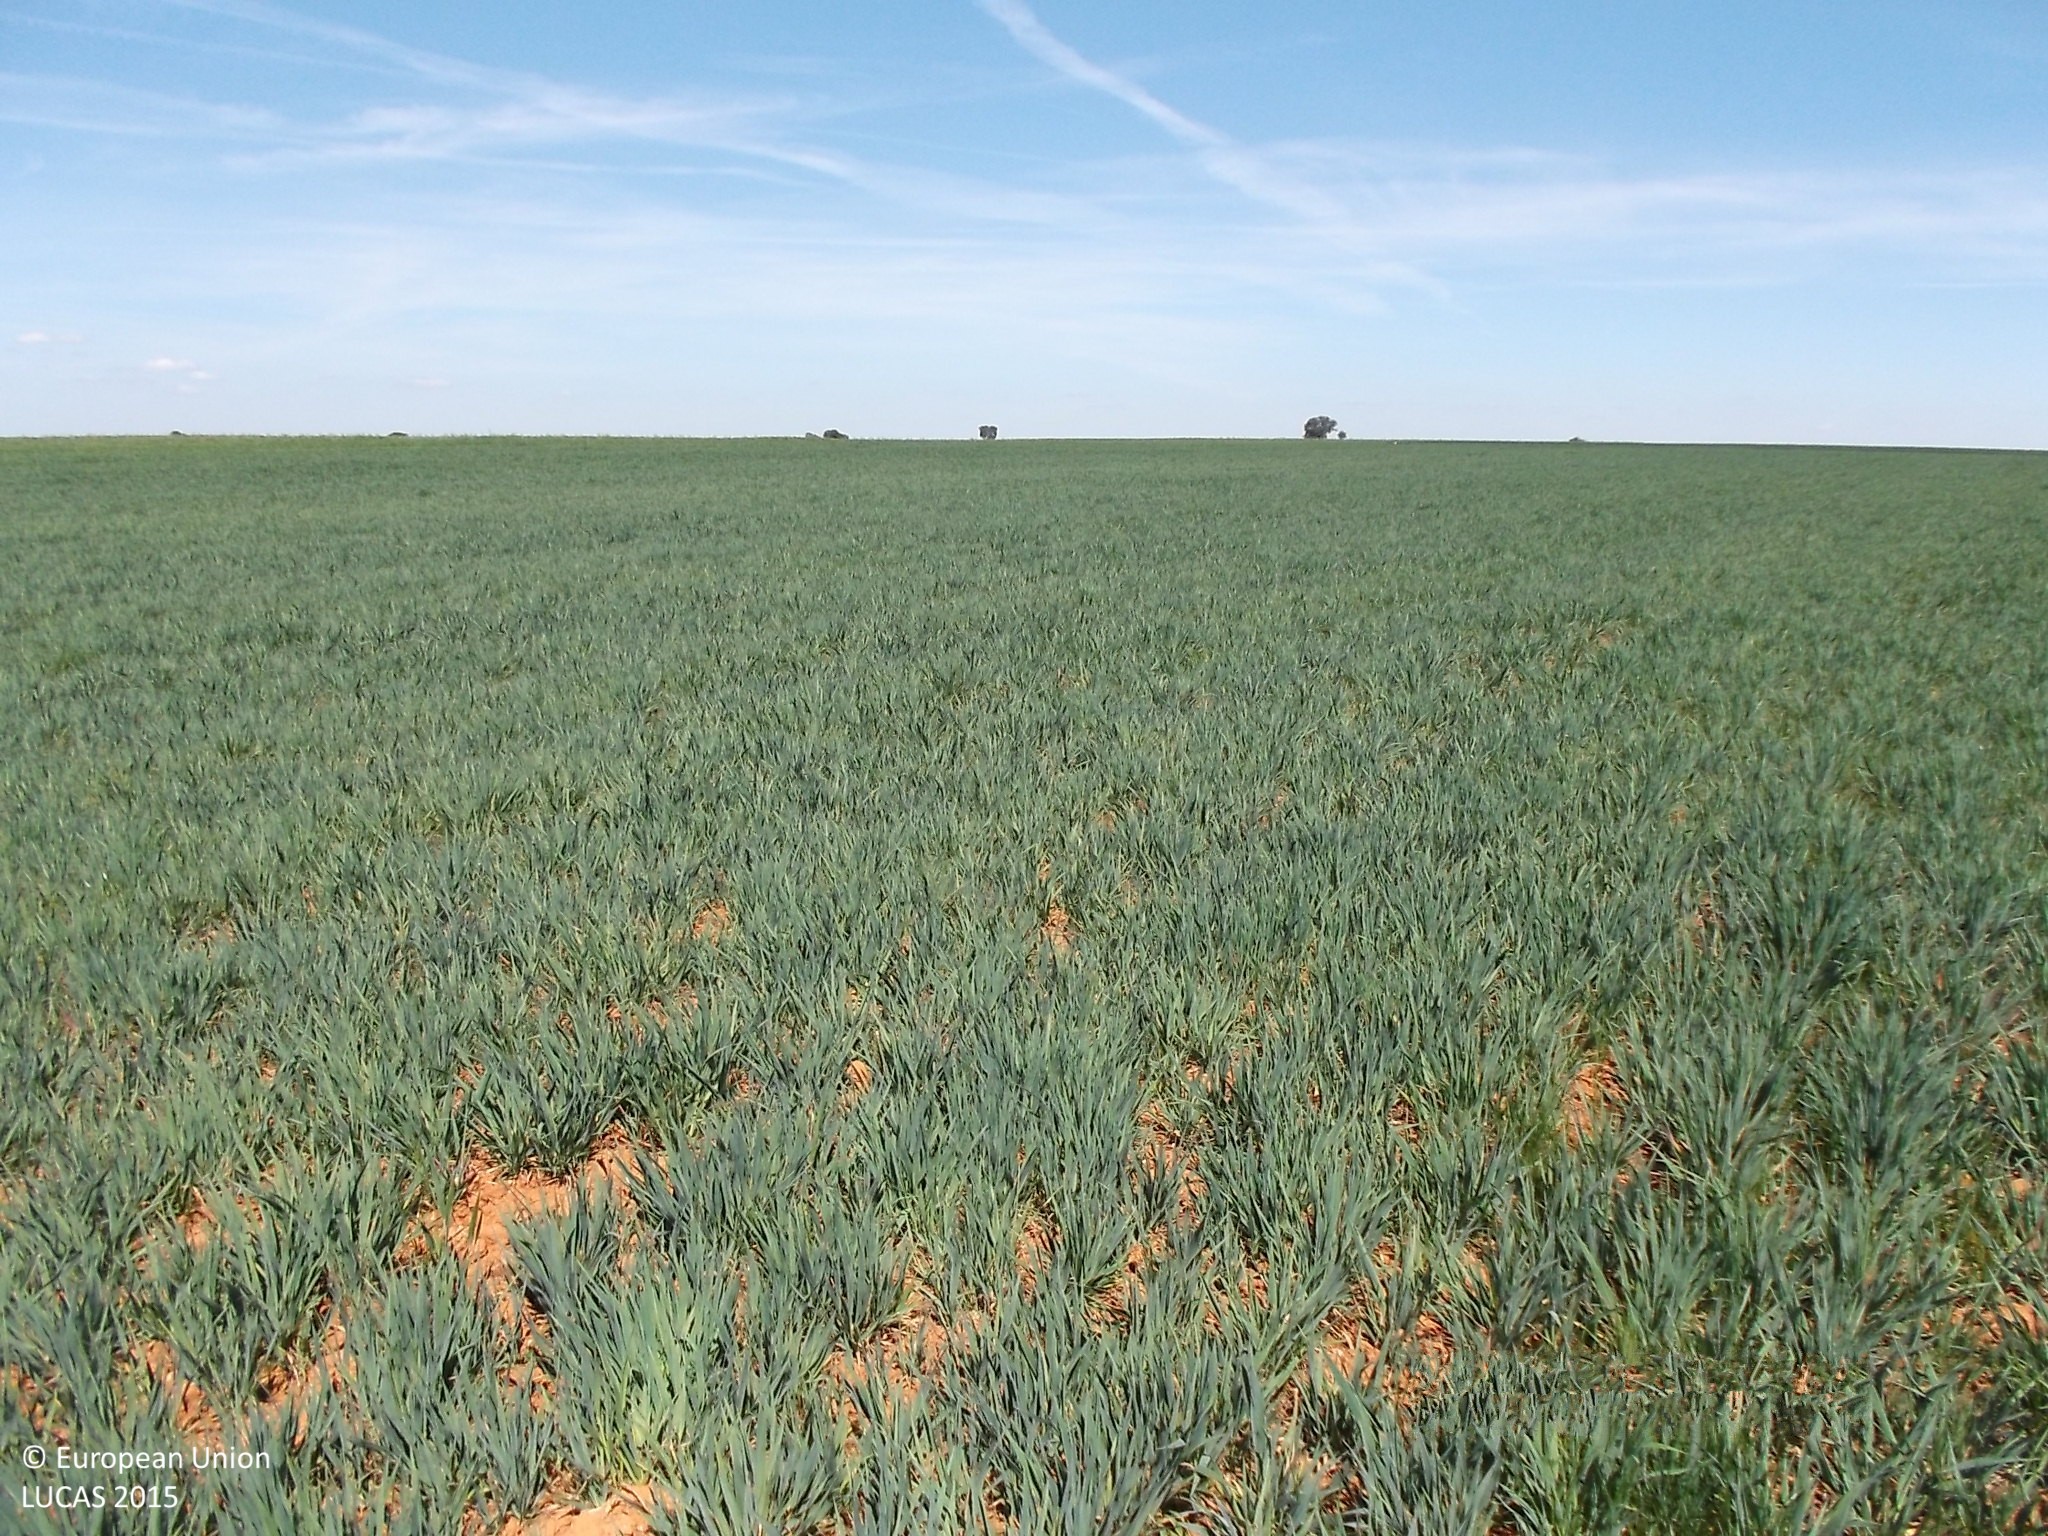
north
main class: Cropland
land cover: Oats
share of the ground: > 75 %
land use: Agriculture (excluding fallow land and kitchen gardens)
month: April
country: ES
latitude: 40.8669
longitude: -5.9444
